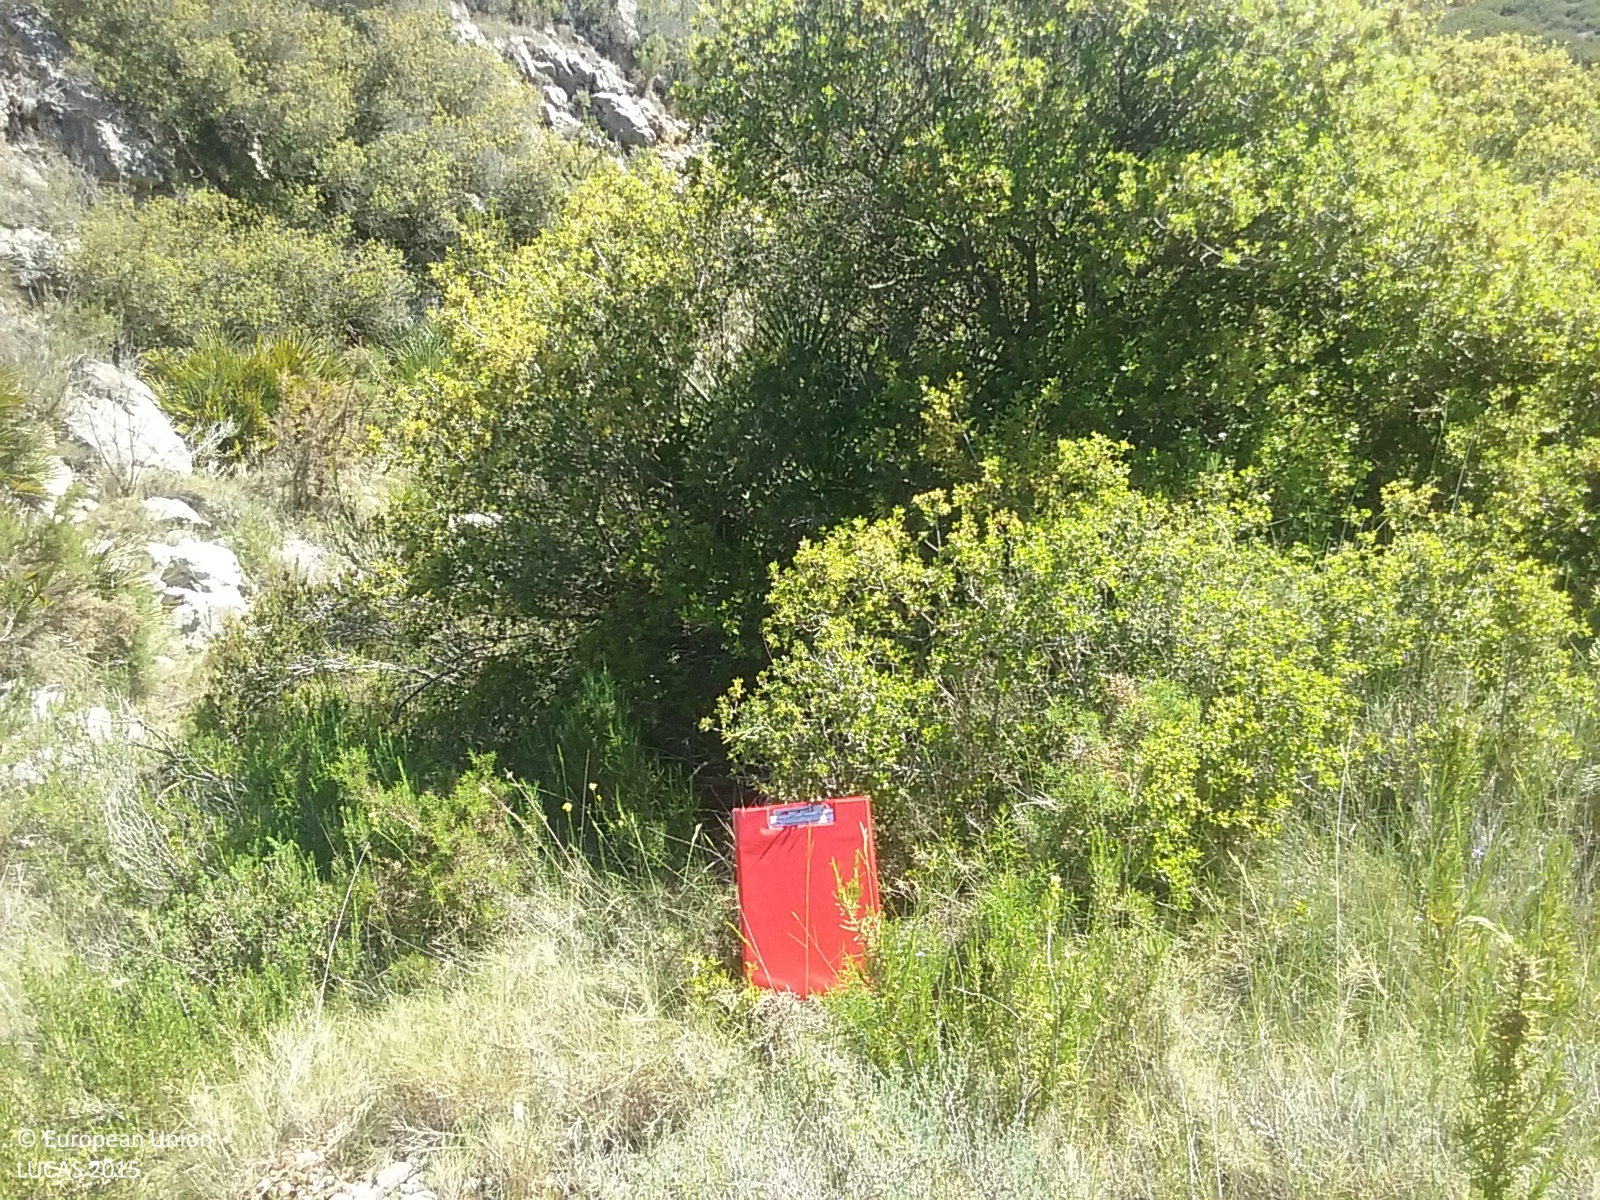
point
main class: Shrubland
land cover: Shrubland with sparse tree cover
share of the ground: > 75 %
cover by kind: shrubs 85 %, broadleaved forest trees 5 %
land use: Semi-natural and natural areas not in use
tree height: < 5 m
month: May
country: ES
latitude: 40.4763
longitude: 0.2880
